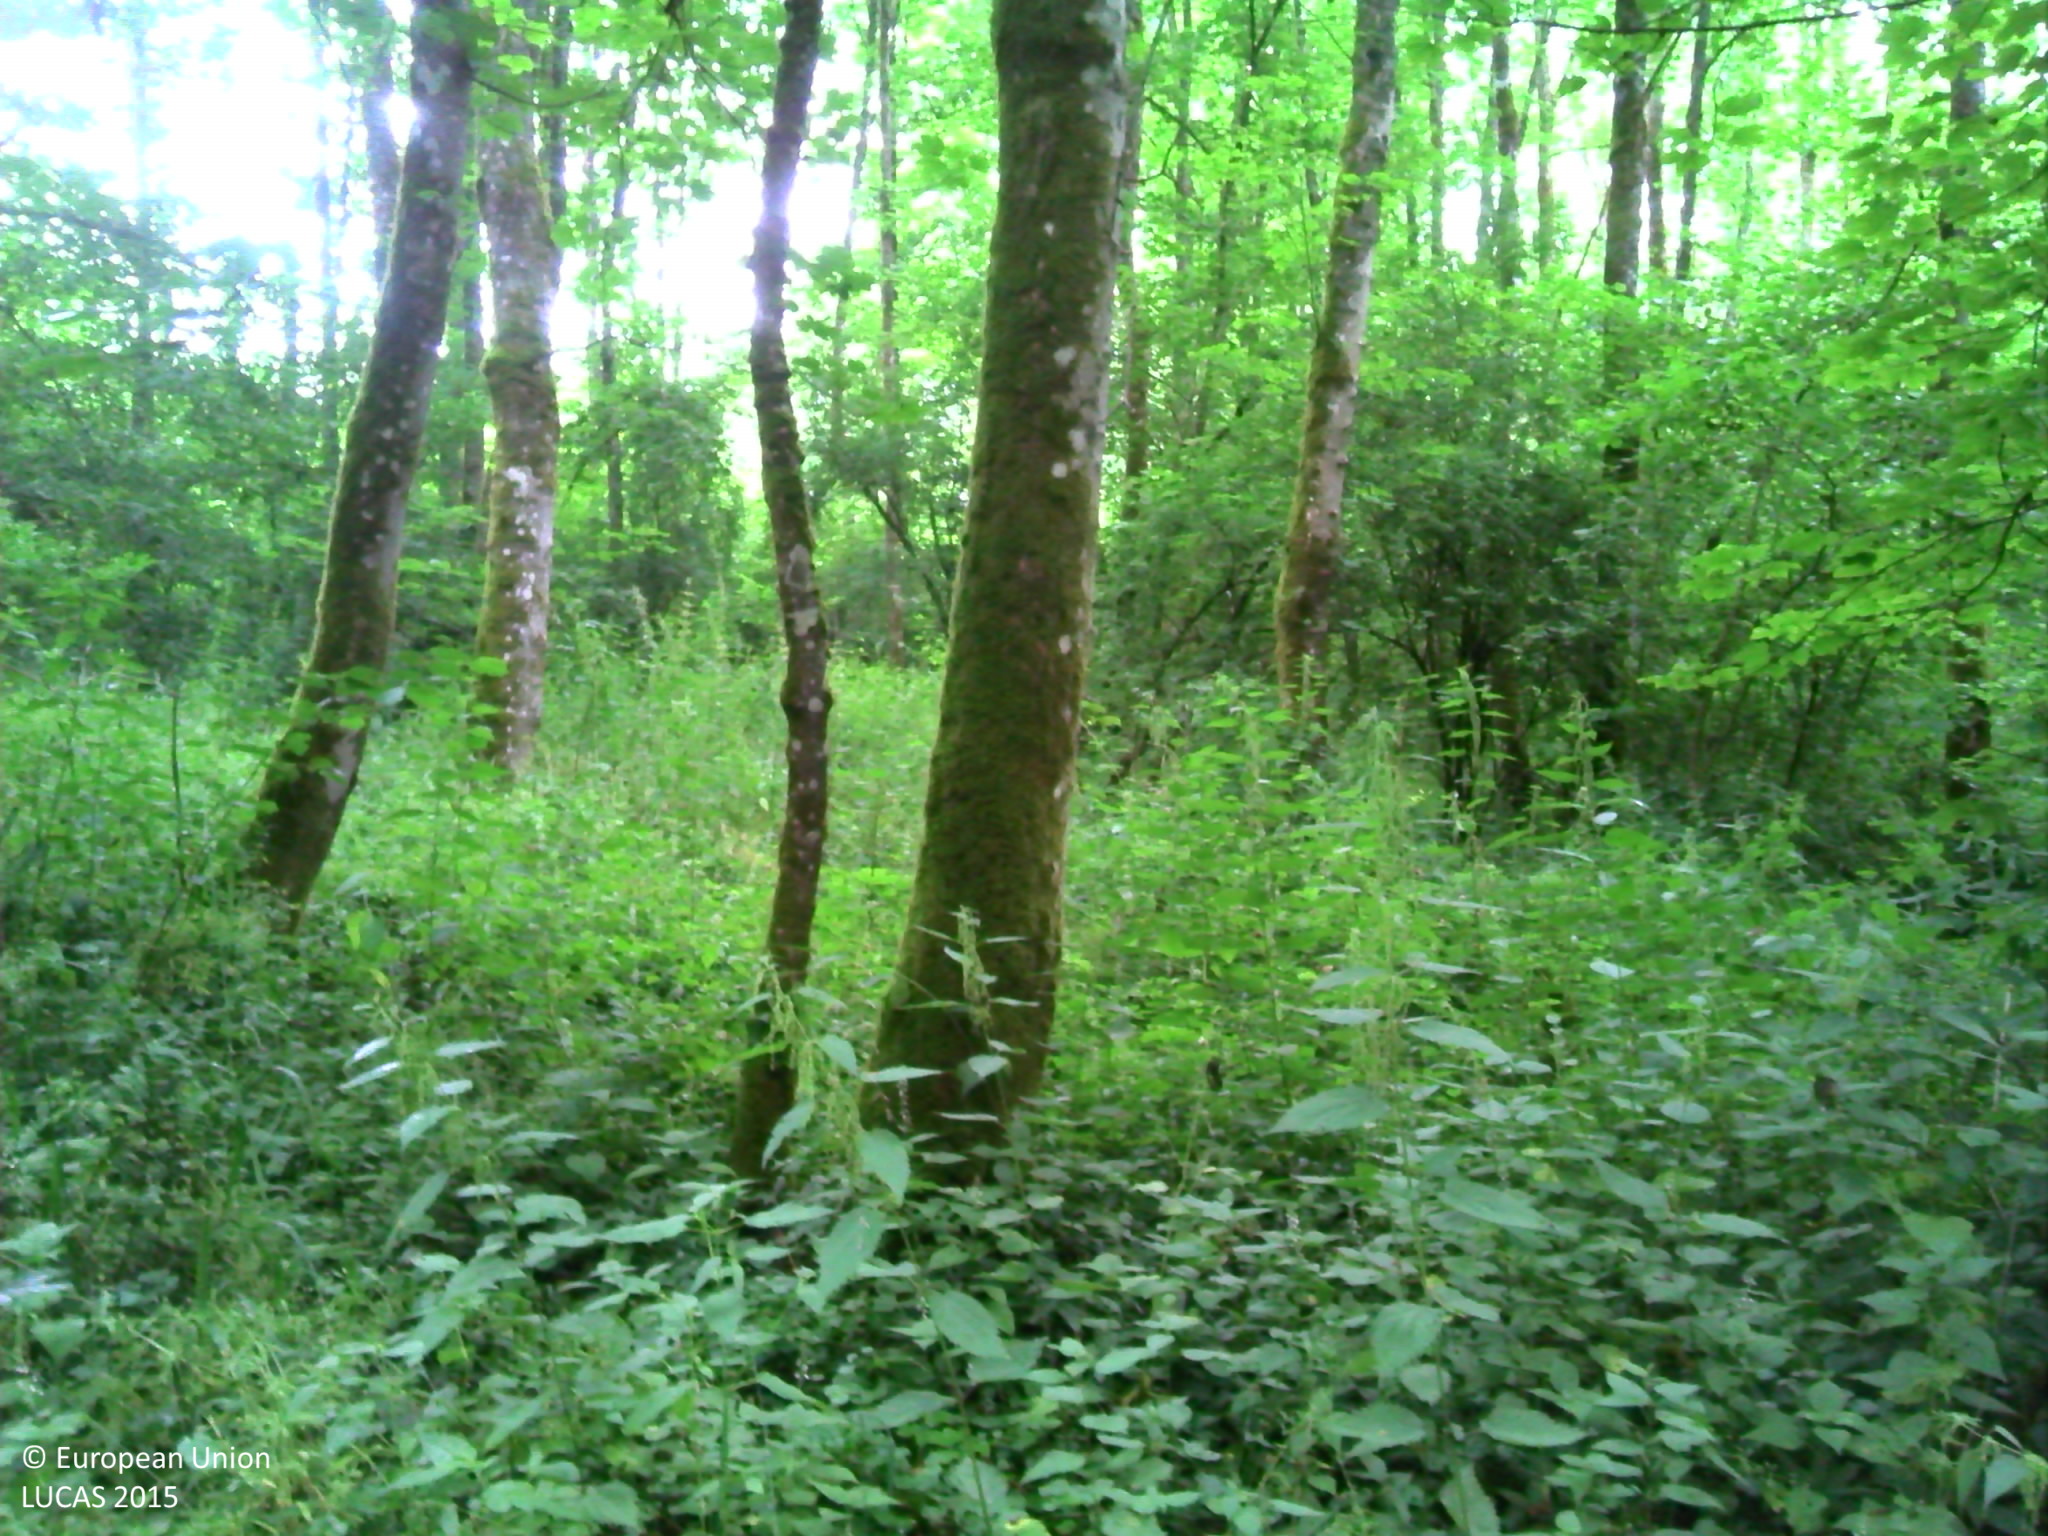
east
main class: Woodland
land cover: Broadleaved woodland
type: mesophytic deciduous forest
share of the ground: > 75 %
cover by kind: broadleaved forest trees 100 %
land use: Forestry
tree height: > 5 m
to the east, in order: Broadleaved woodland; Ditches and canals; Broadleaved woodland; Tracks; Broadleaved woodland; Spruce dominated mixed woodland; Broadleaved woodland
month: July
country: BE
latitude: 50.2032
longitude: 4.6584
